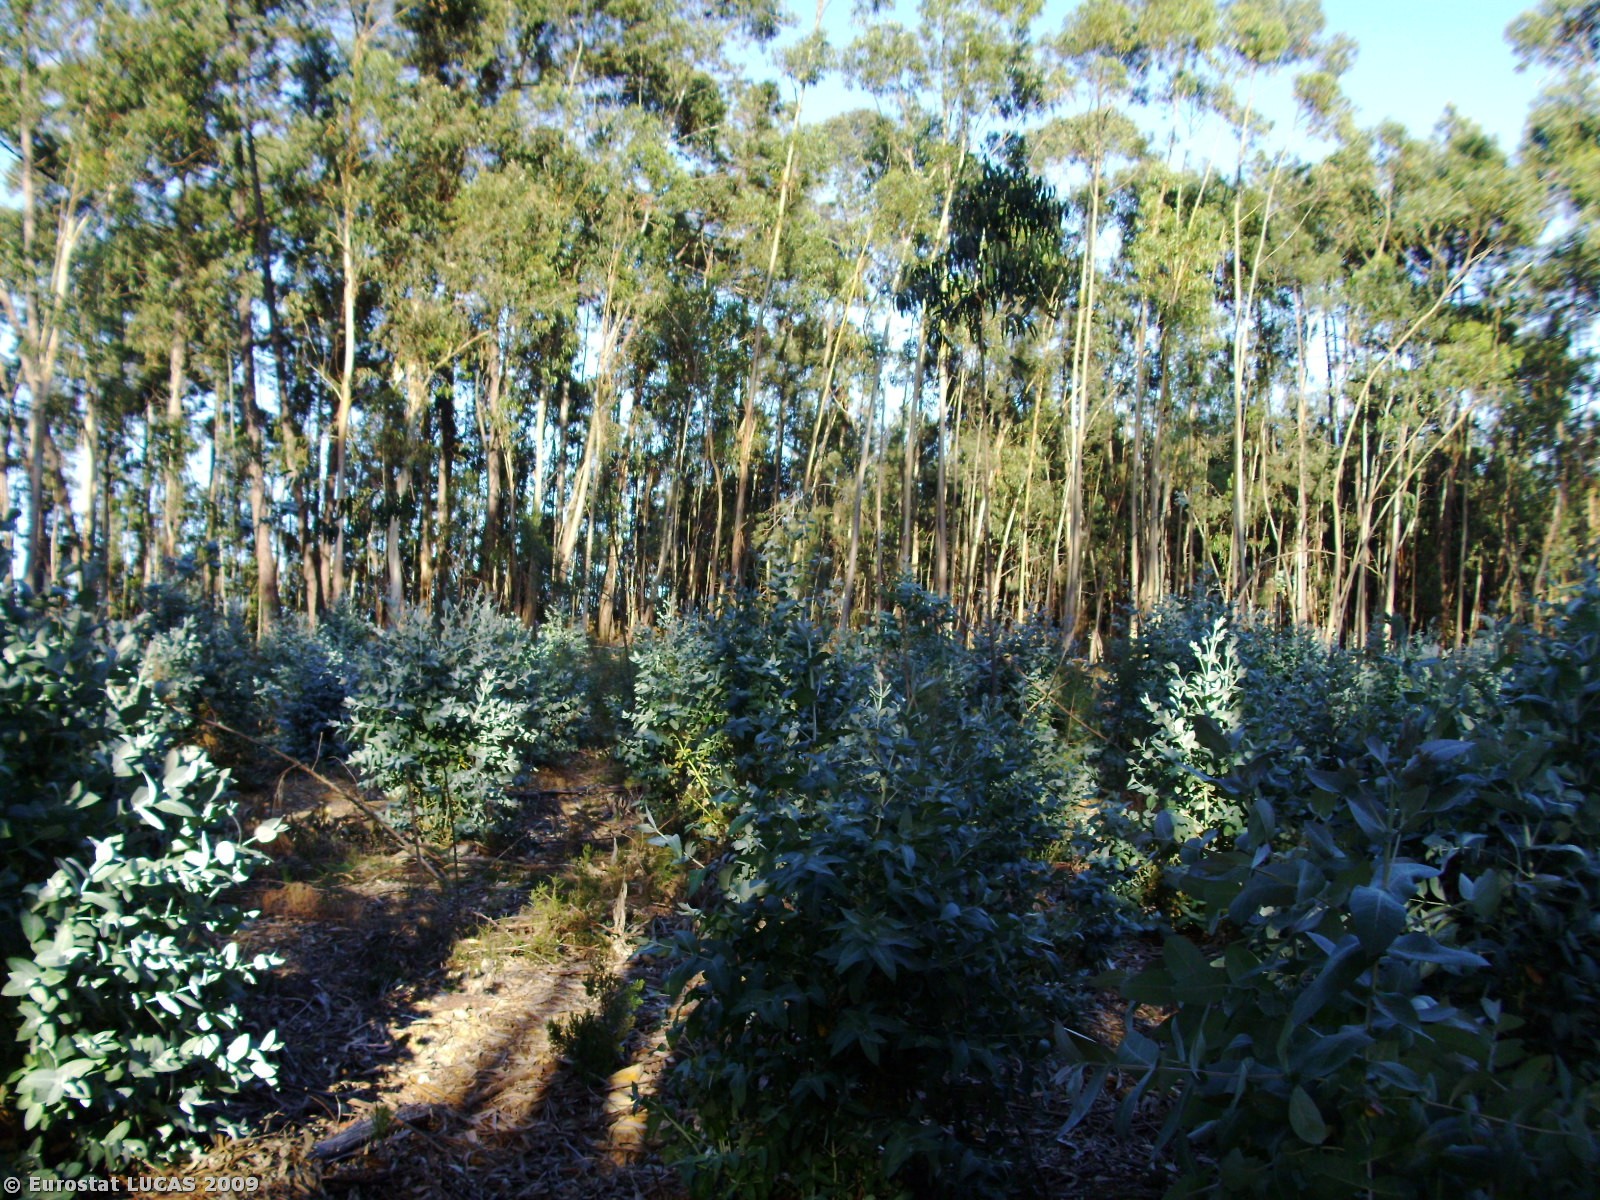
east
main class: Woodland
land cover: Broadleaved woodland
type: plantations and self-sown exotic forest
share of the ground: > 75 %
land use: Forestry
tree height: > 5 m
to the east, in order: Broadleaved woodland; Tracks; Broadleaved woodland; Mixed woodland; Broadleaved woodland; Tracks; Broadleaved woodland; Tracks; Broadleaved woodland
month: May
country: PT
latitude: 40.6183
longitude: -8.3999
